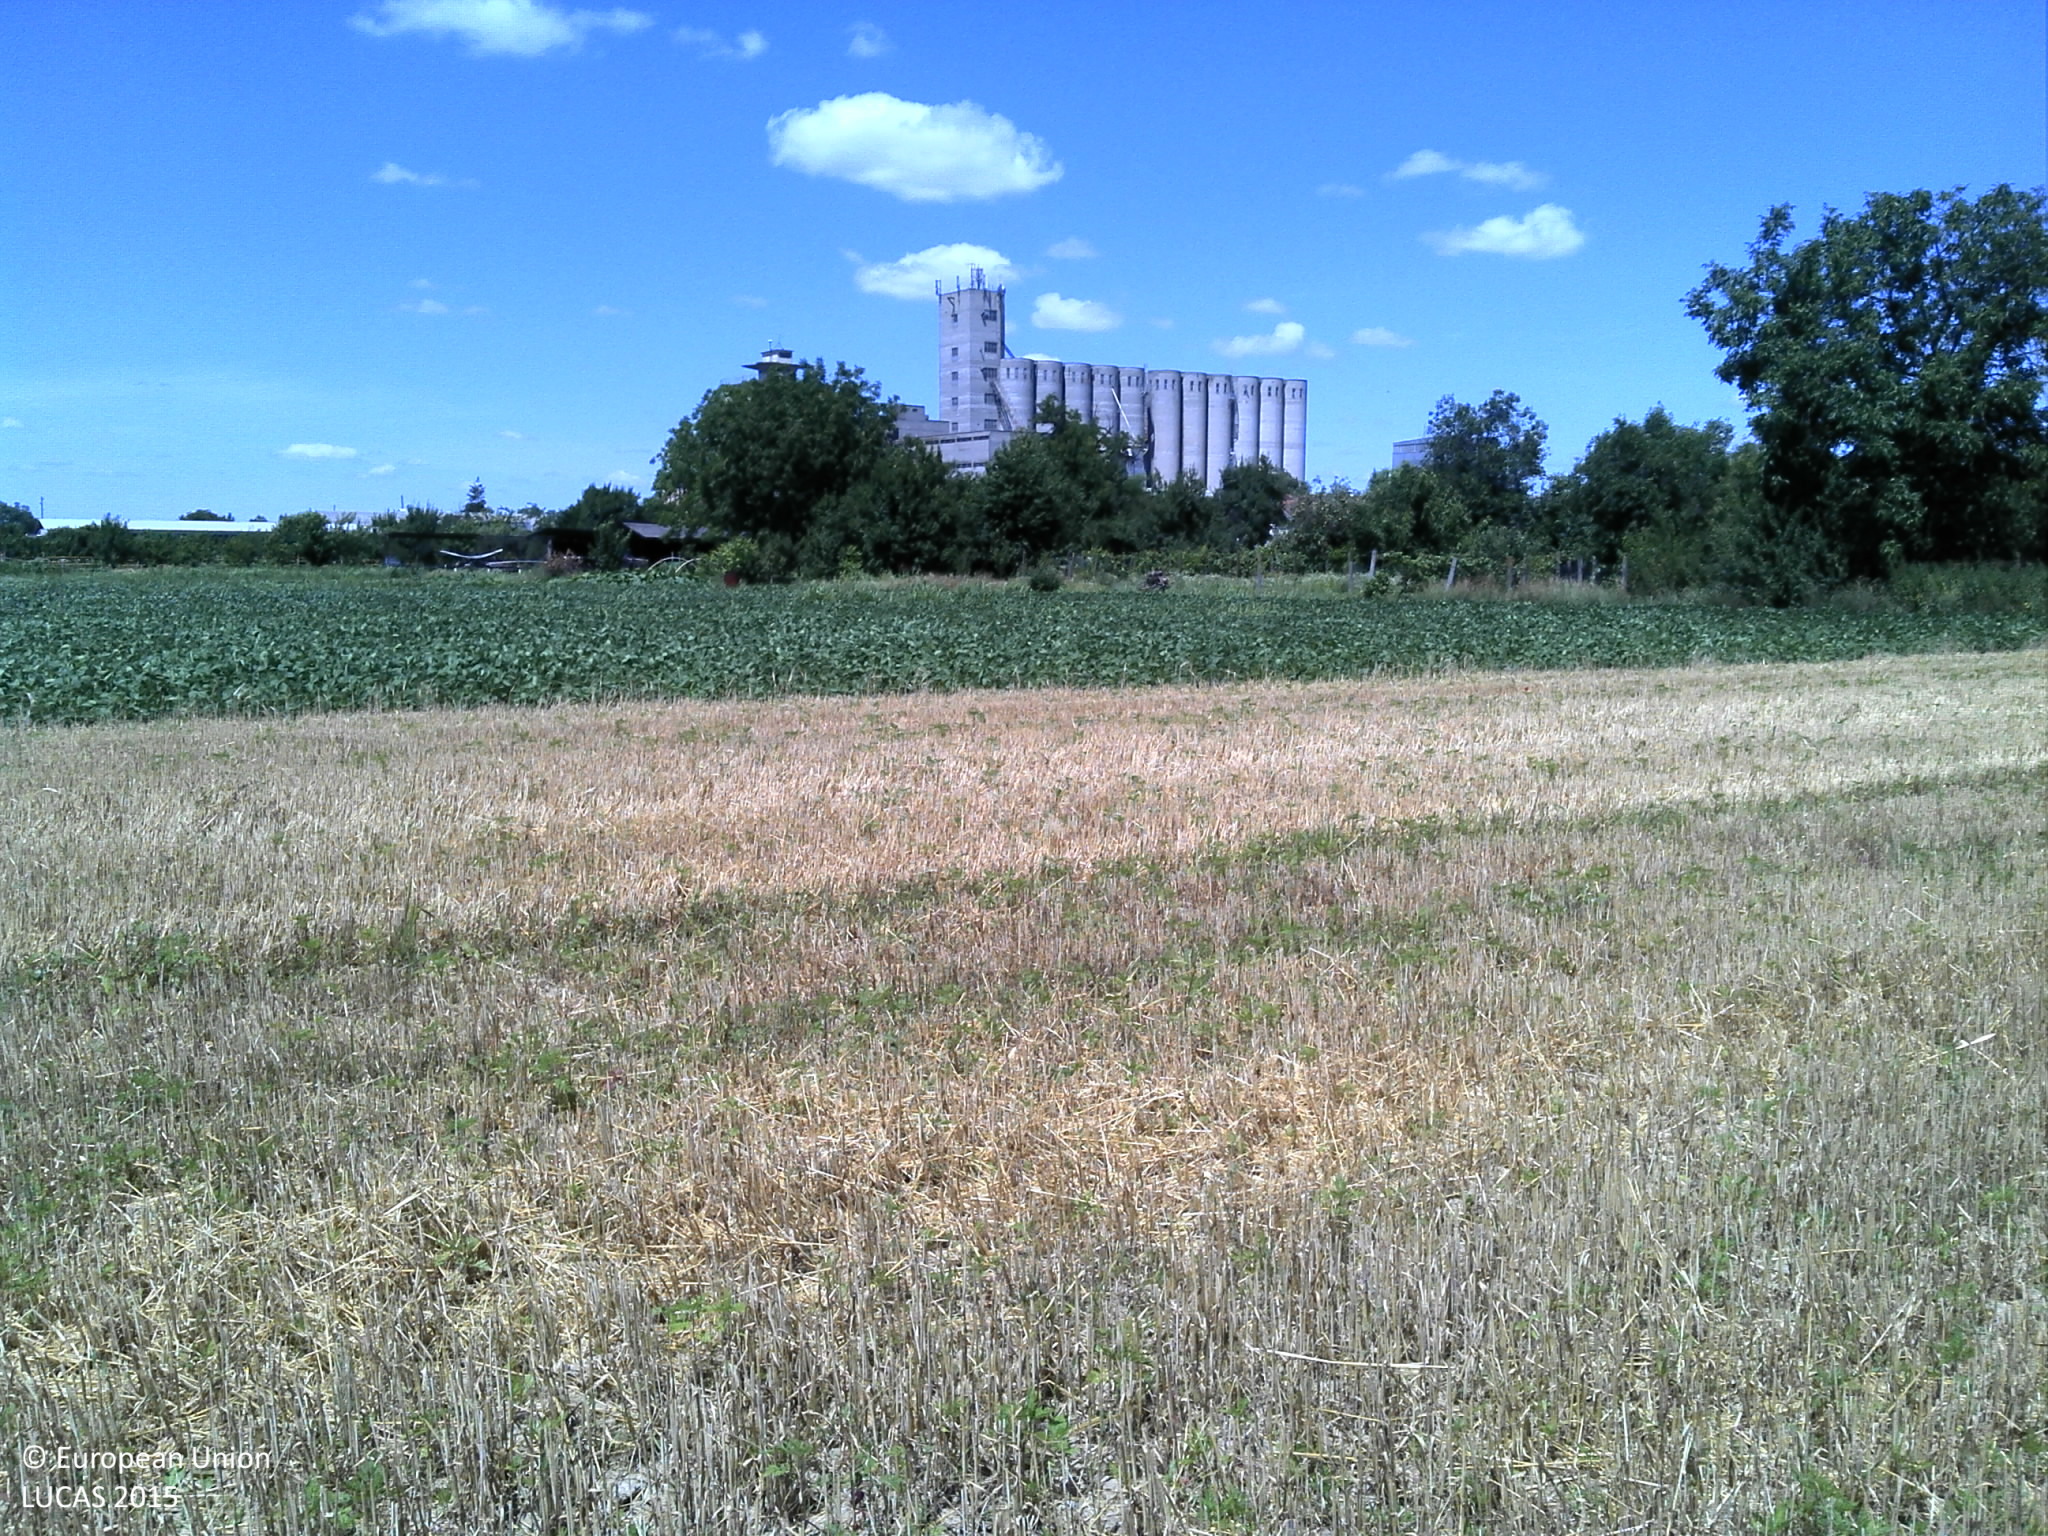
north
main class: Cropland
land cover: Barley
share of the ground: < 10 %
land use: Agriculture (excluding fallow land and kitchen gardens)
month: June
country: HR
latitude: 45.7488
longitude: 18.1681
